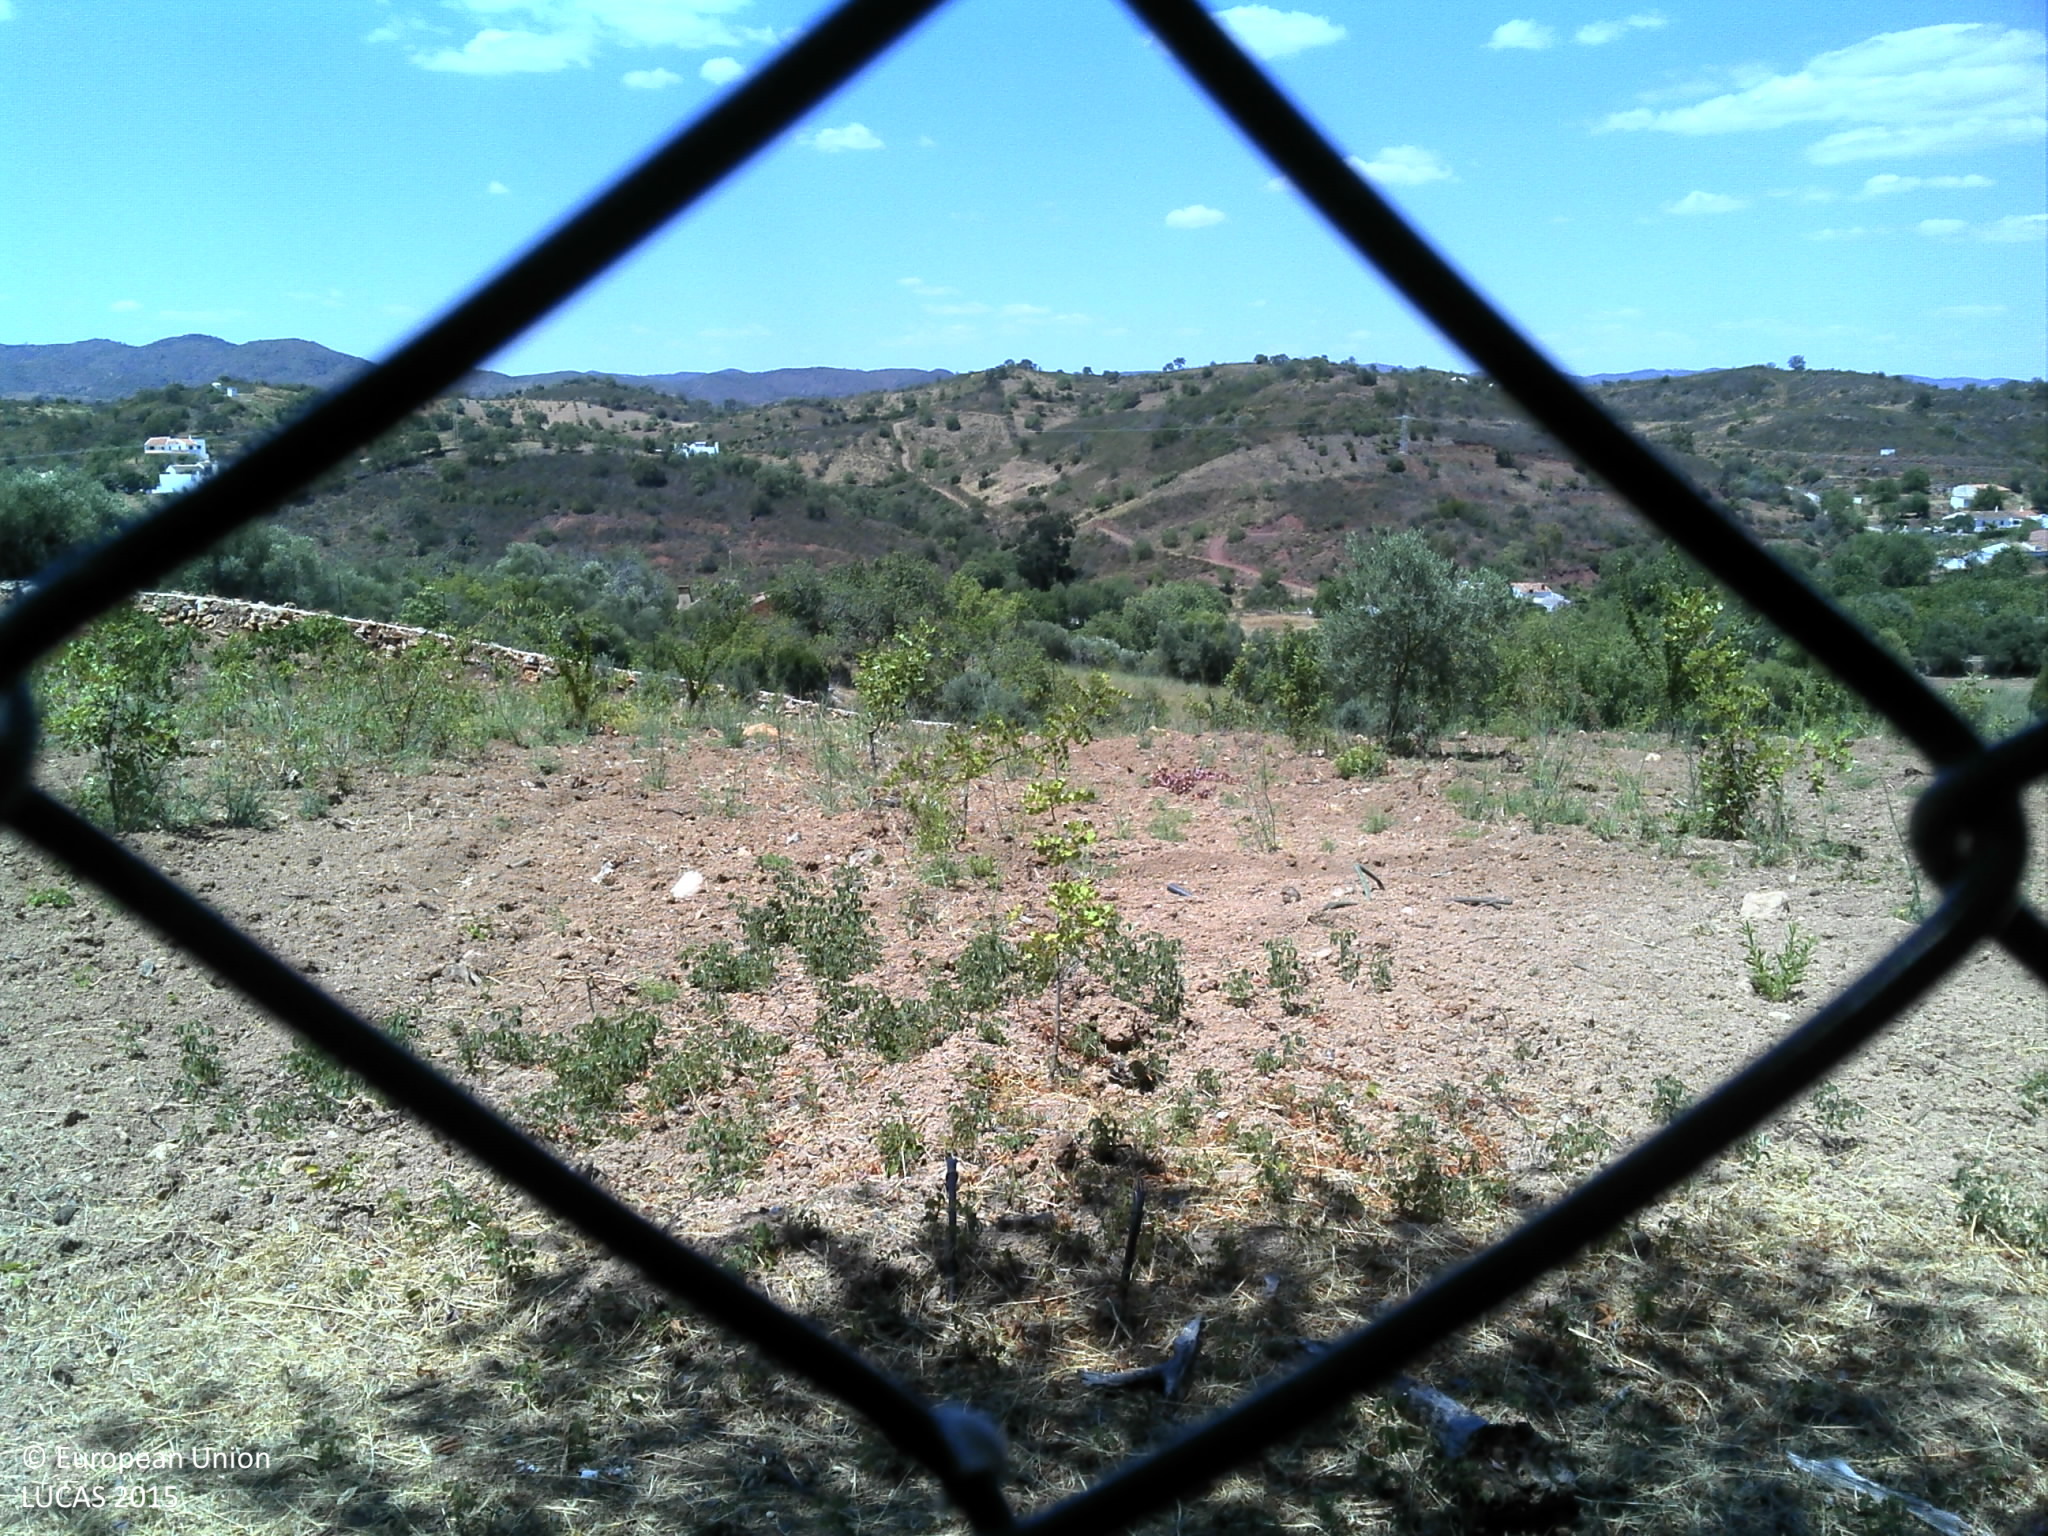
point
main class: Cropland
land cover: Permanent industrial crops
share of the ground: < 10 %
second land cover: Spontaneously vegetated surfaces
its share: 10 - 25 %
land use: Agriculture (excluding fallow land and kitchen gardens)
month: June
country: PT
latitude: 37.1524
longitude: -7.7641
